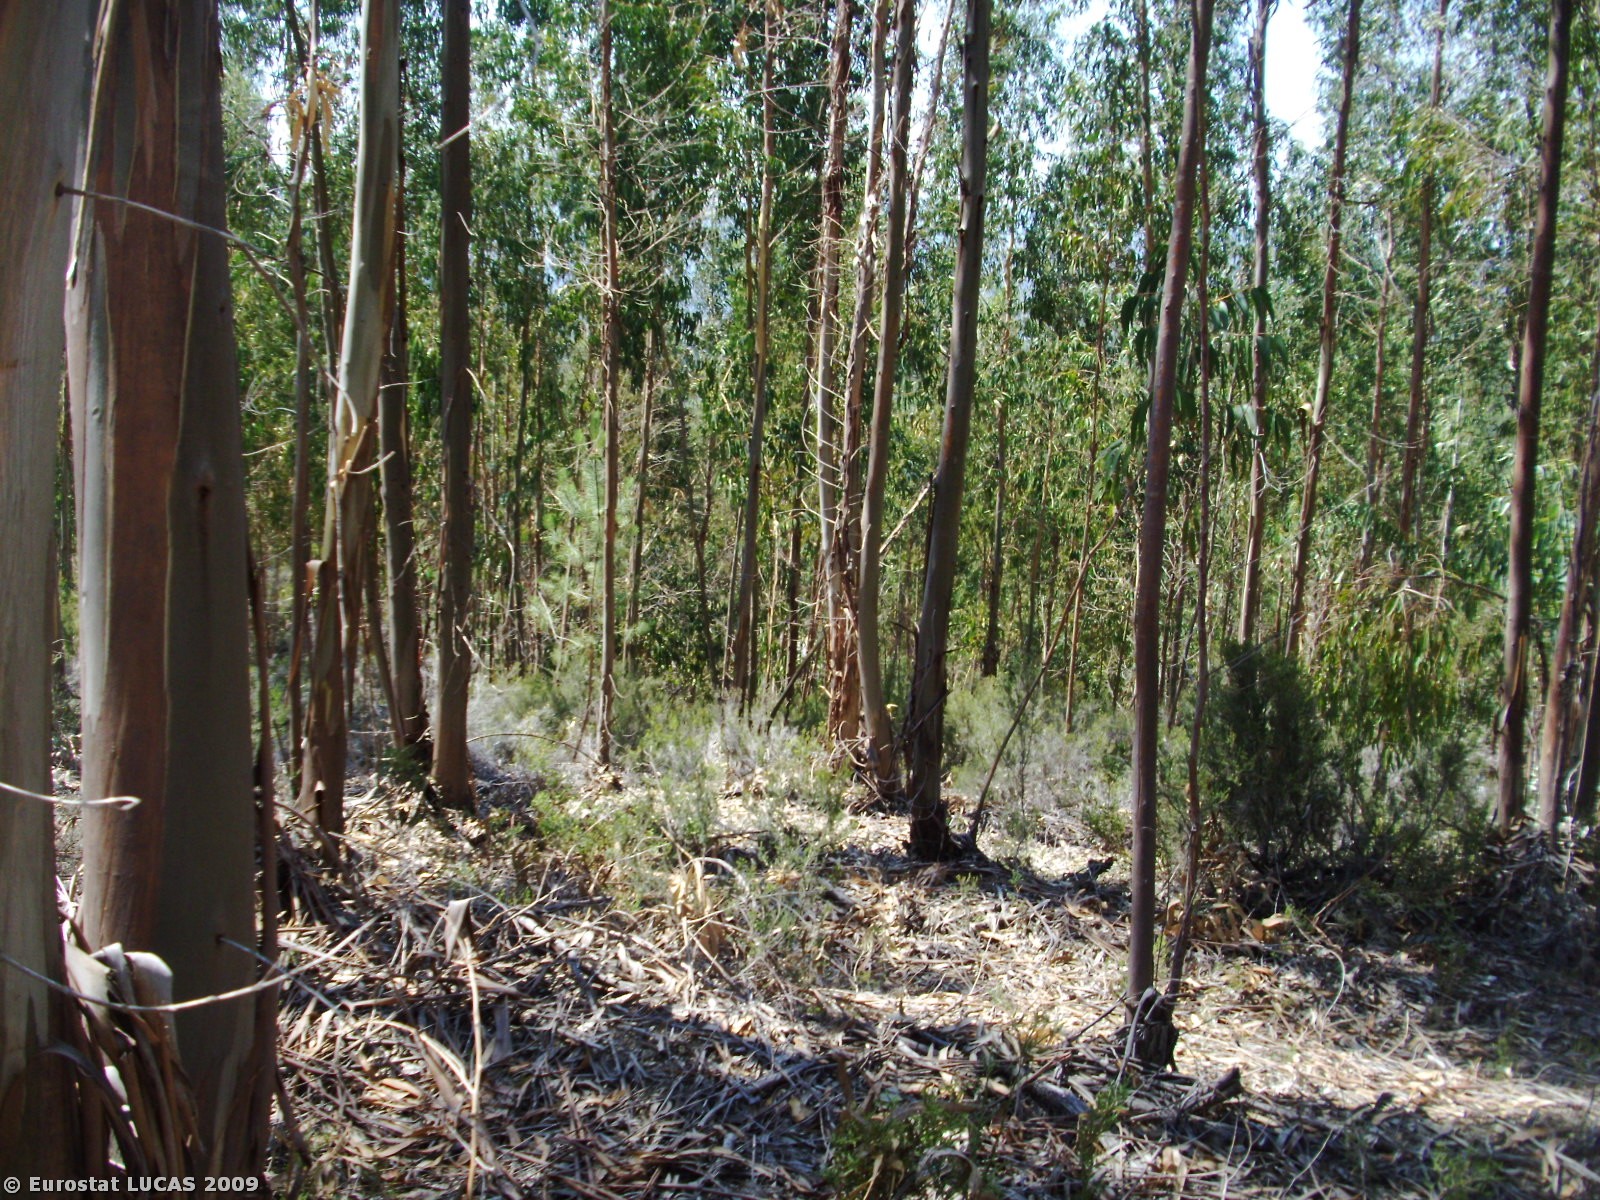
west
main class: Woodland
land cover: Broadleaved woodland
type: plantations and self-sown exotic forest
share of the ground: > 75 %
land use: Forestry
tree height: > 5 m
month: August
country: PT
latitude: 40.1553
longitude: -7.6121
